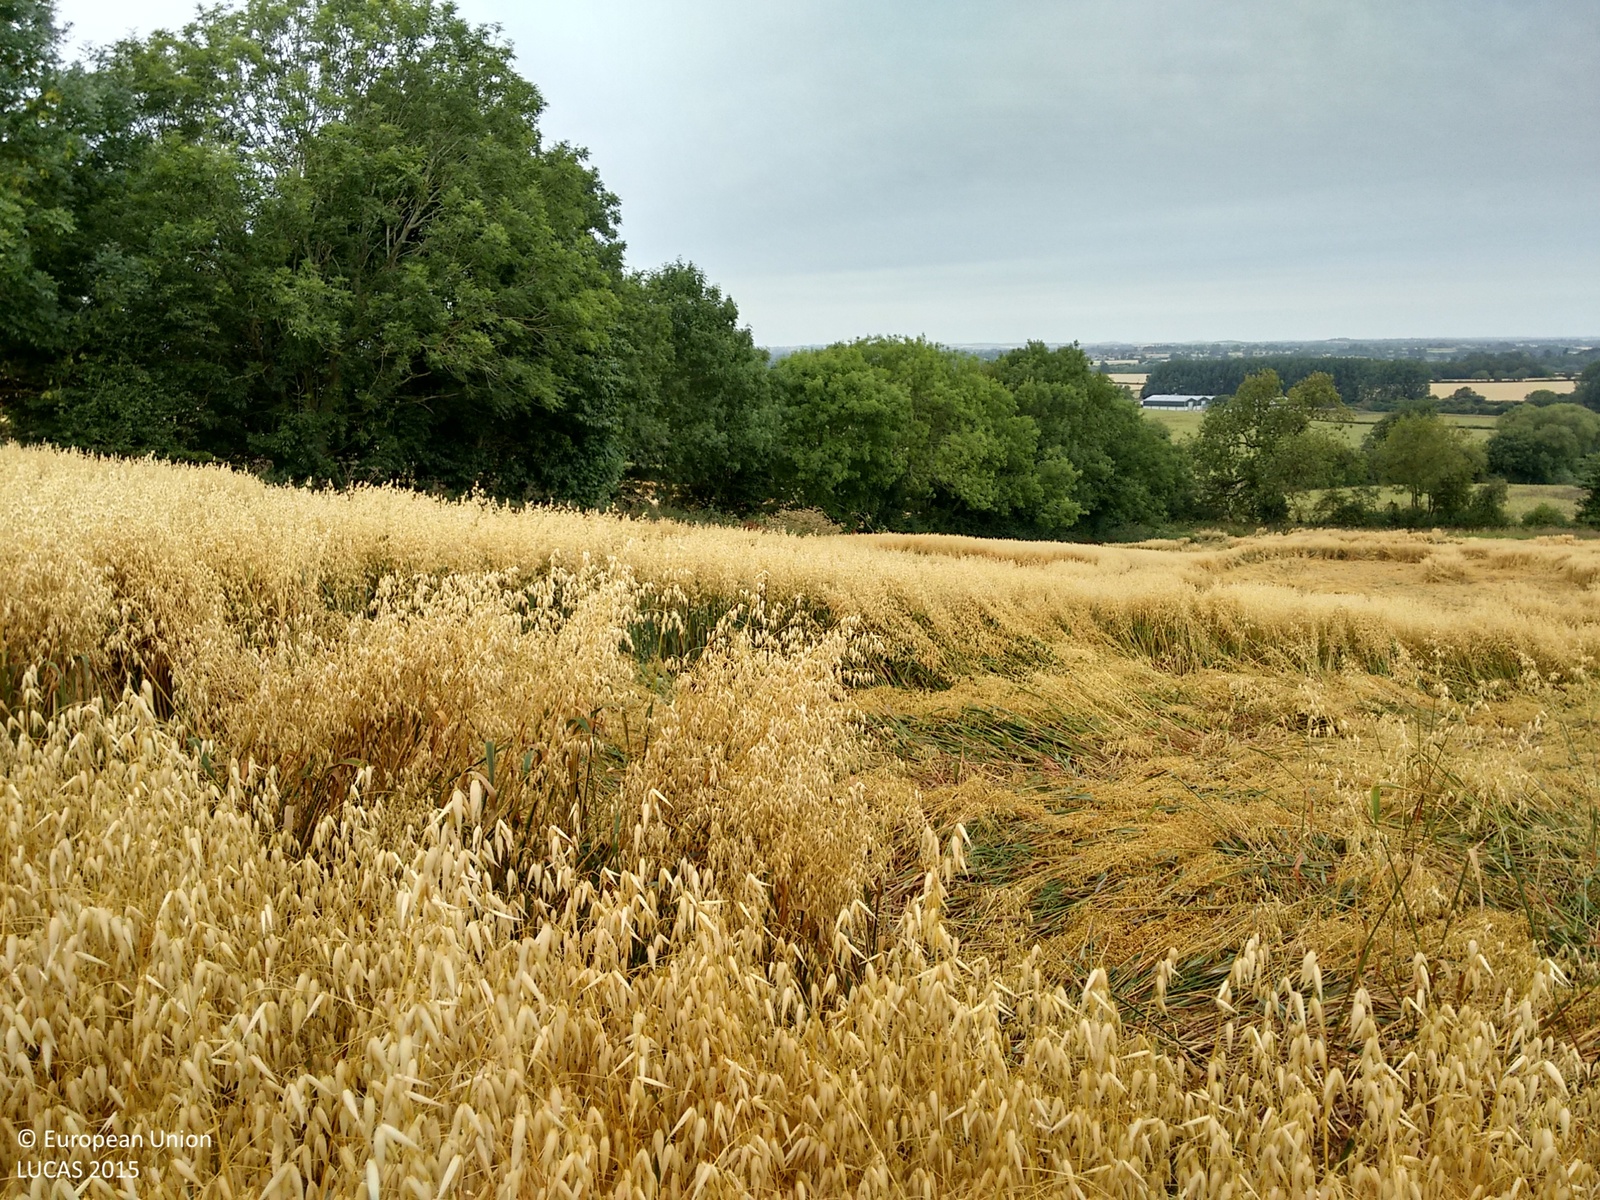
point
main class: Woodland
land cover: Broadleaved woodland
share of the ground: > 75 %
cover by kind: broadleaved forest trees 95 %, shrubs 5 %
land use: Semi-natural and natural areas not in use
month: August
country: GB
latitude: 52.0042
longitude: -1.2499
